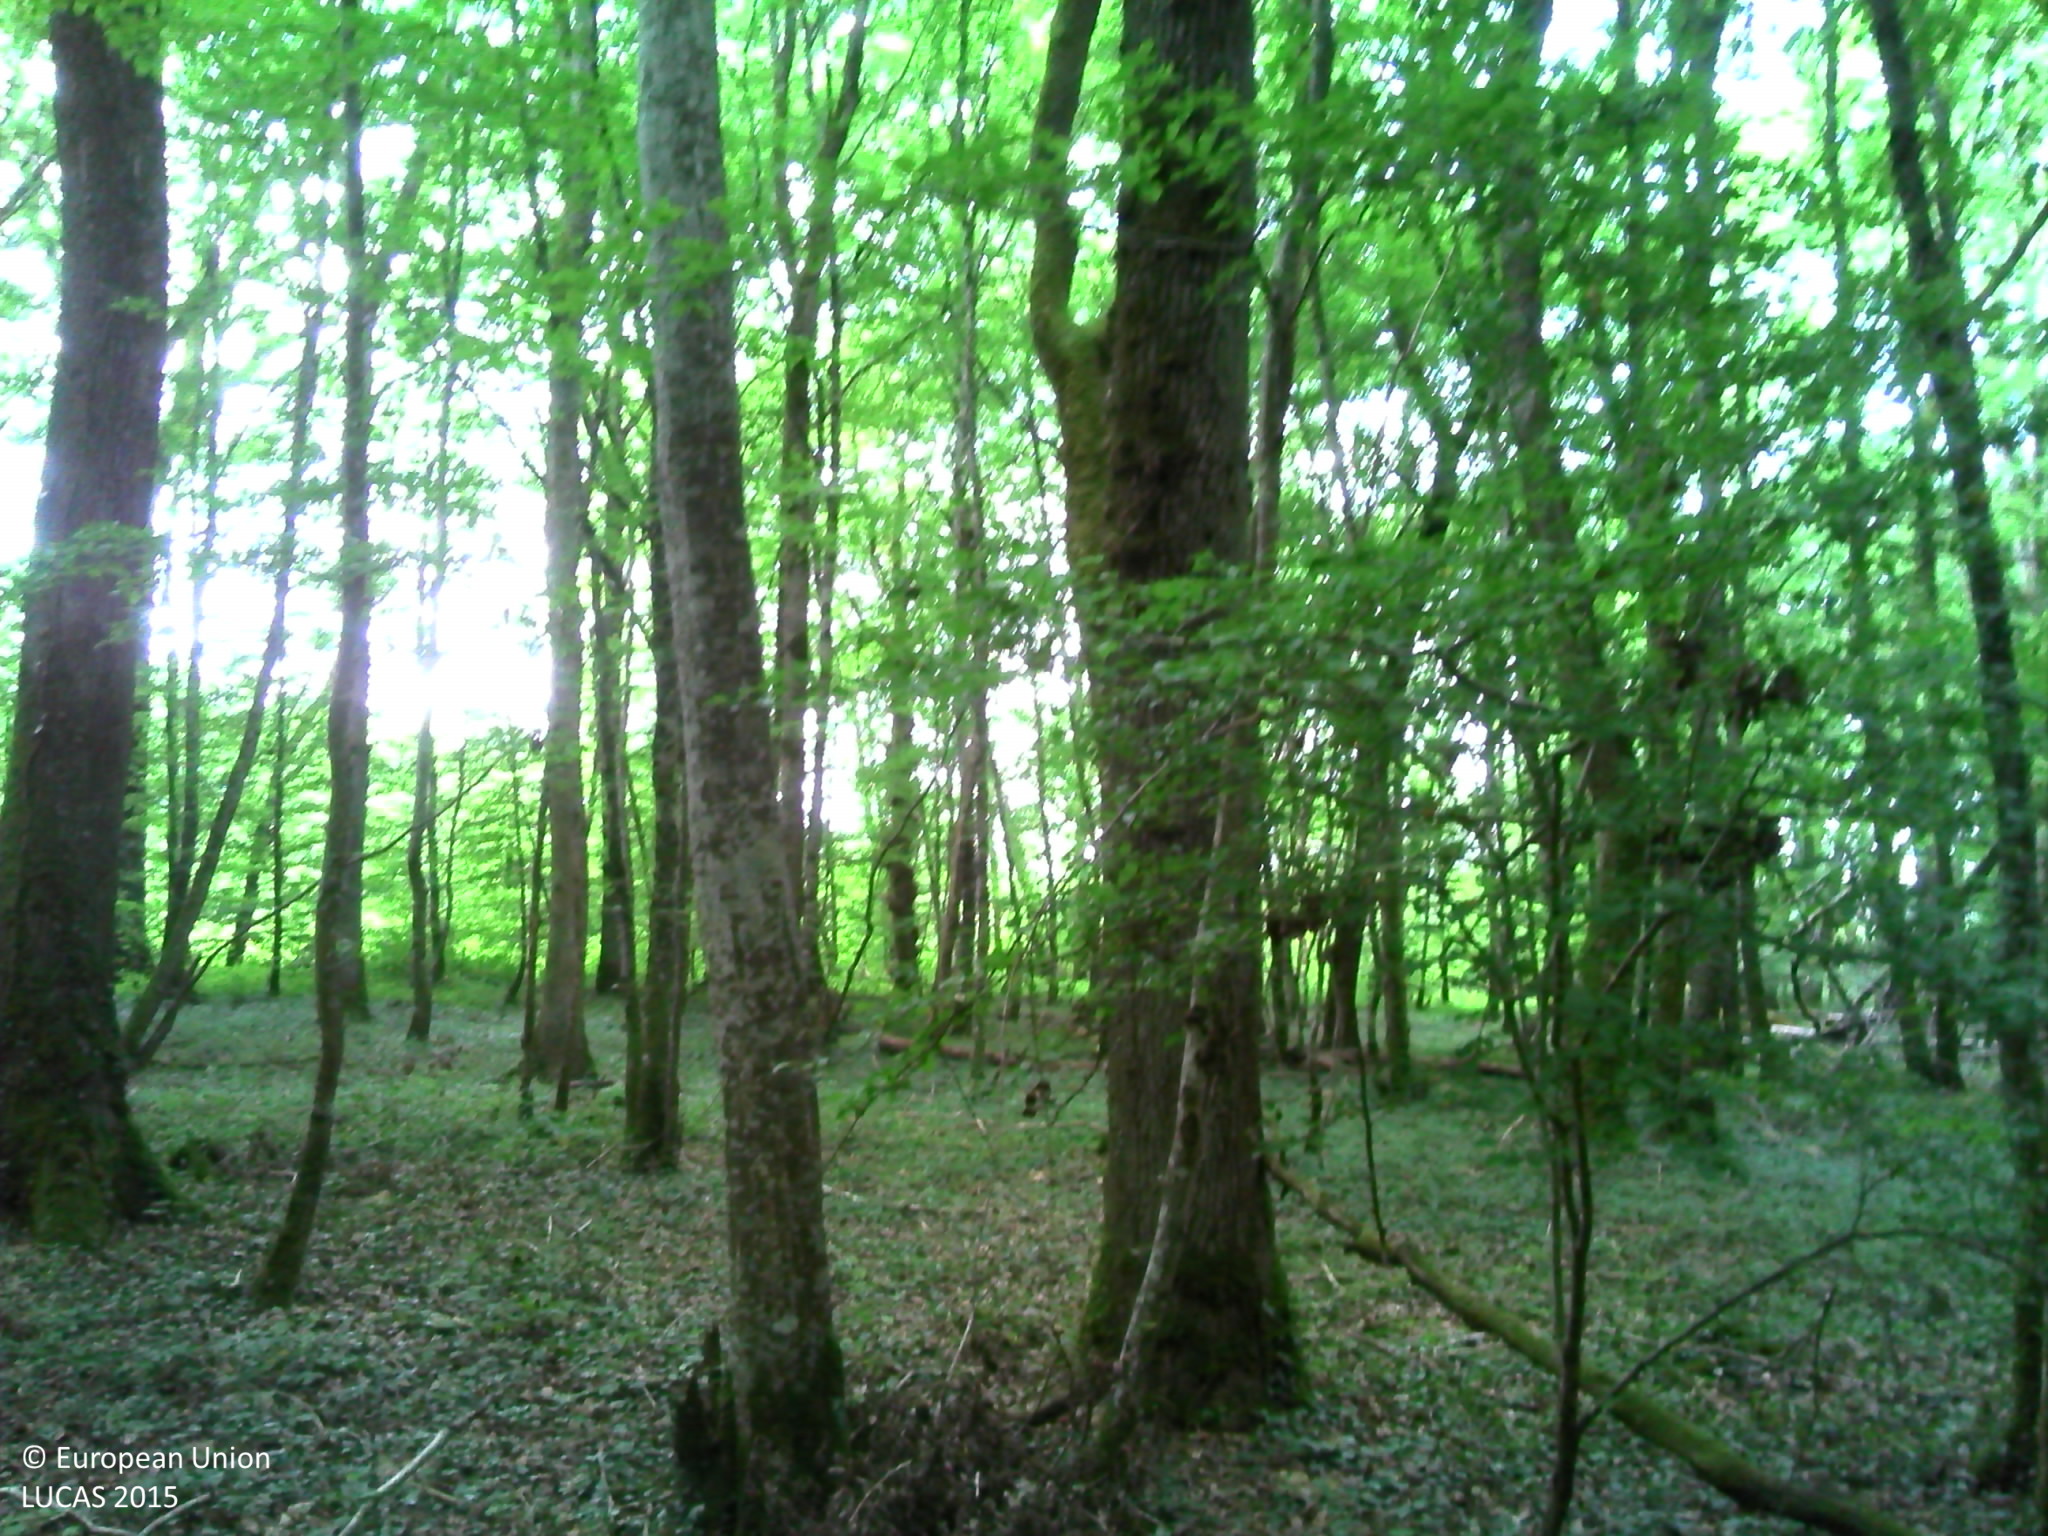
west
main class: Woodland
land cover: Broadleaved woodland
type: beech forest
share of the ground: > 75 %
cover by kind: broadleaved forest trees 90 %, herbaceous plants 10 %
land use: Forestry
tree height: > 5 m
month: July
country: FR
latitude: 47.3158
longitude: 3.6074
